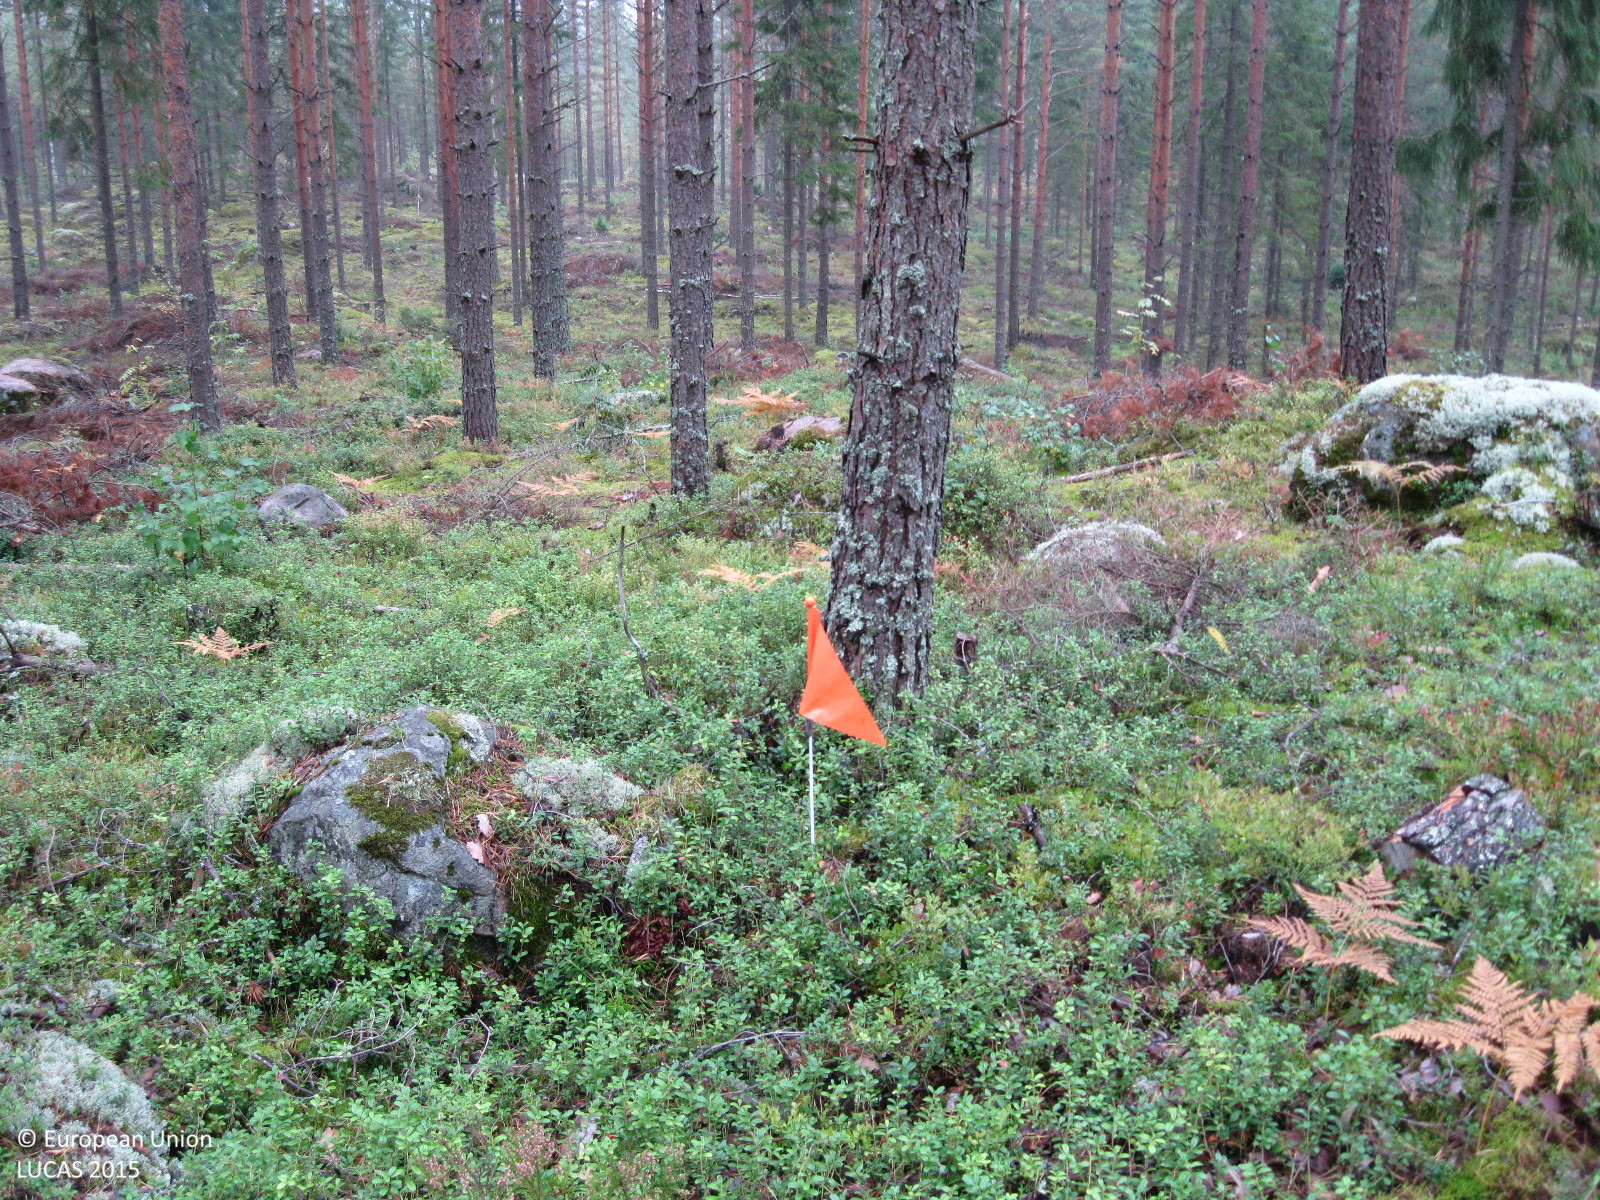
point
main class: Woodland
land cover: Pine dominated coniferous woodland
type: boreal forest
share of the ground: 50 - 75 %
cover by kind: coniferous forest trees 55 %, shrubs 30 %, lichens and mosses 15 %
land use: Forestry
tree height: > 5 m
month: September
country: FI
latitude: 60.8925
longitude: 24.8728
